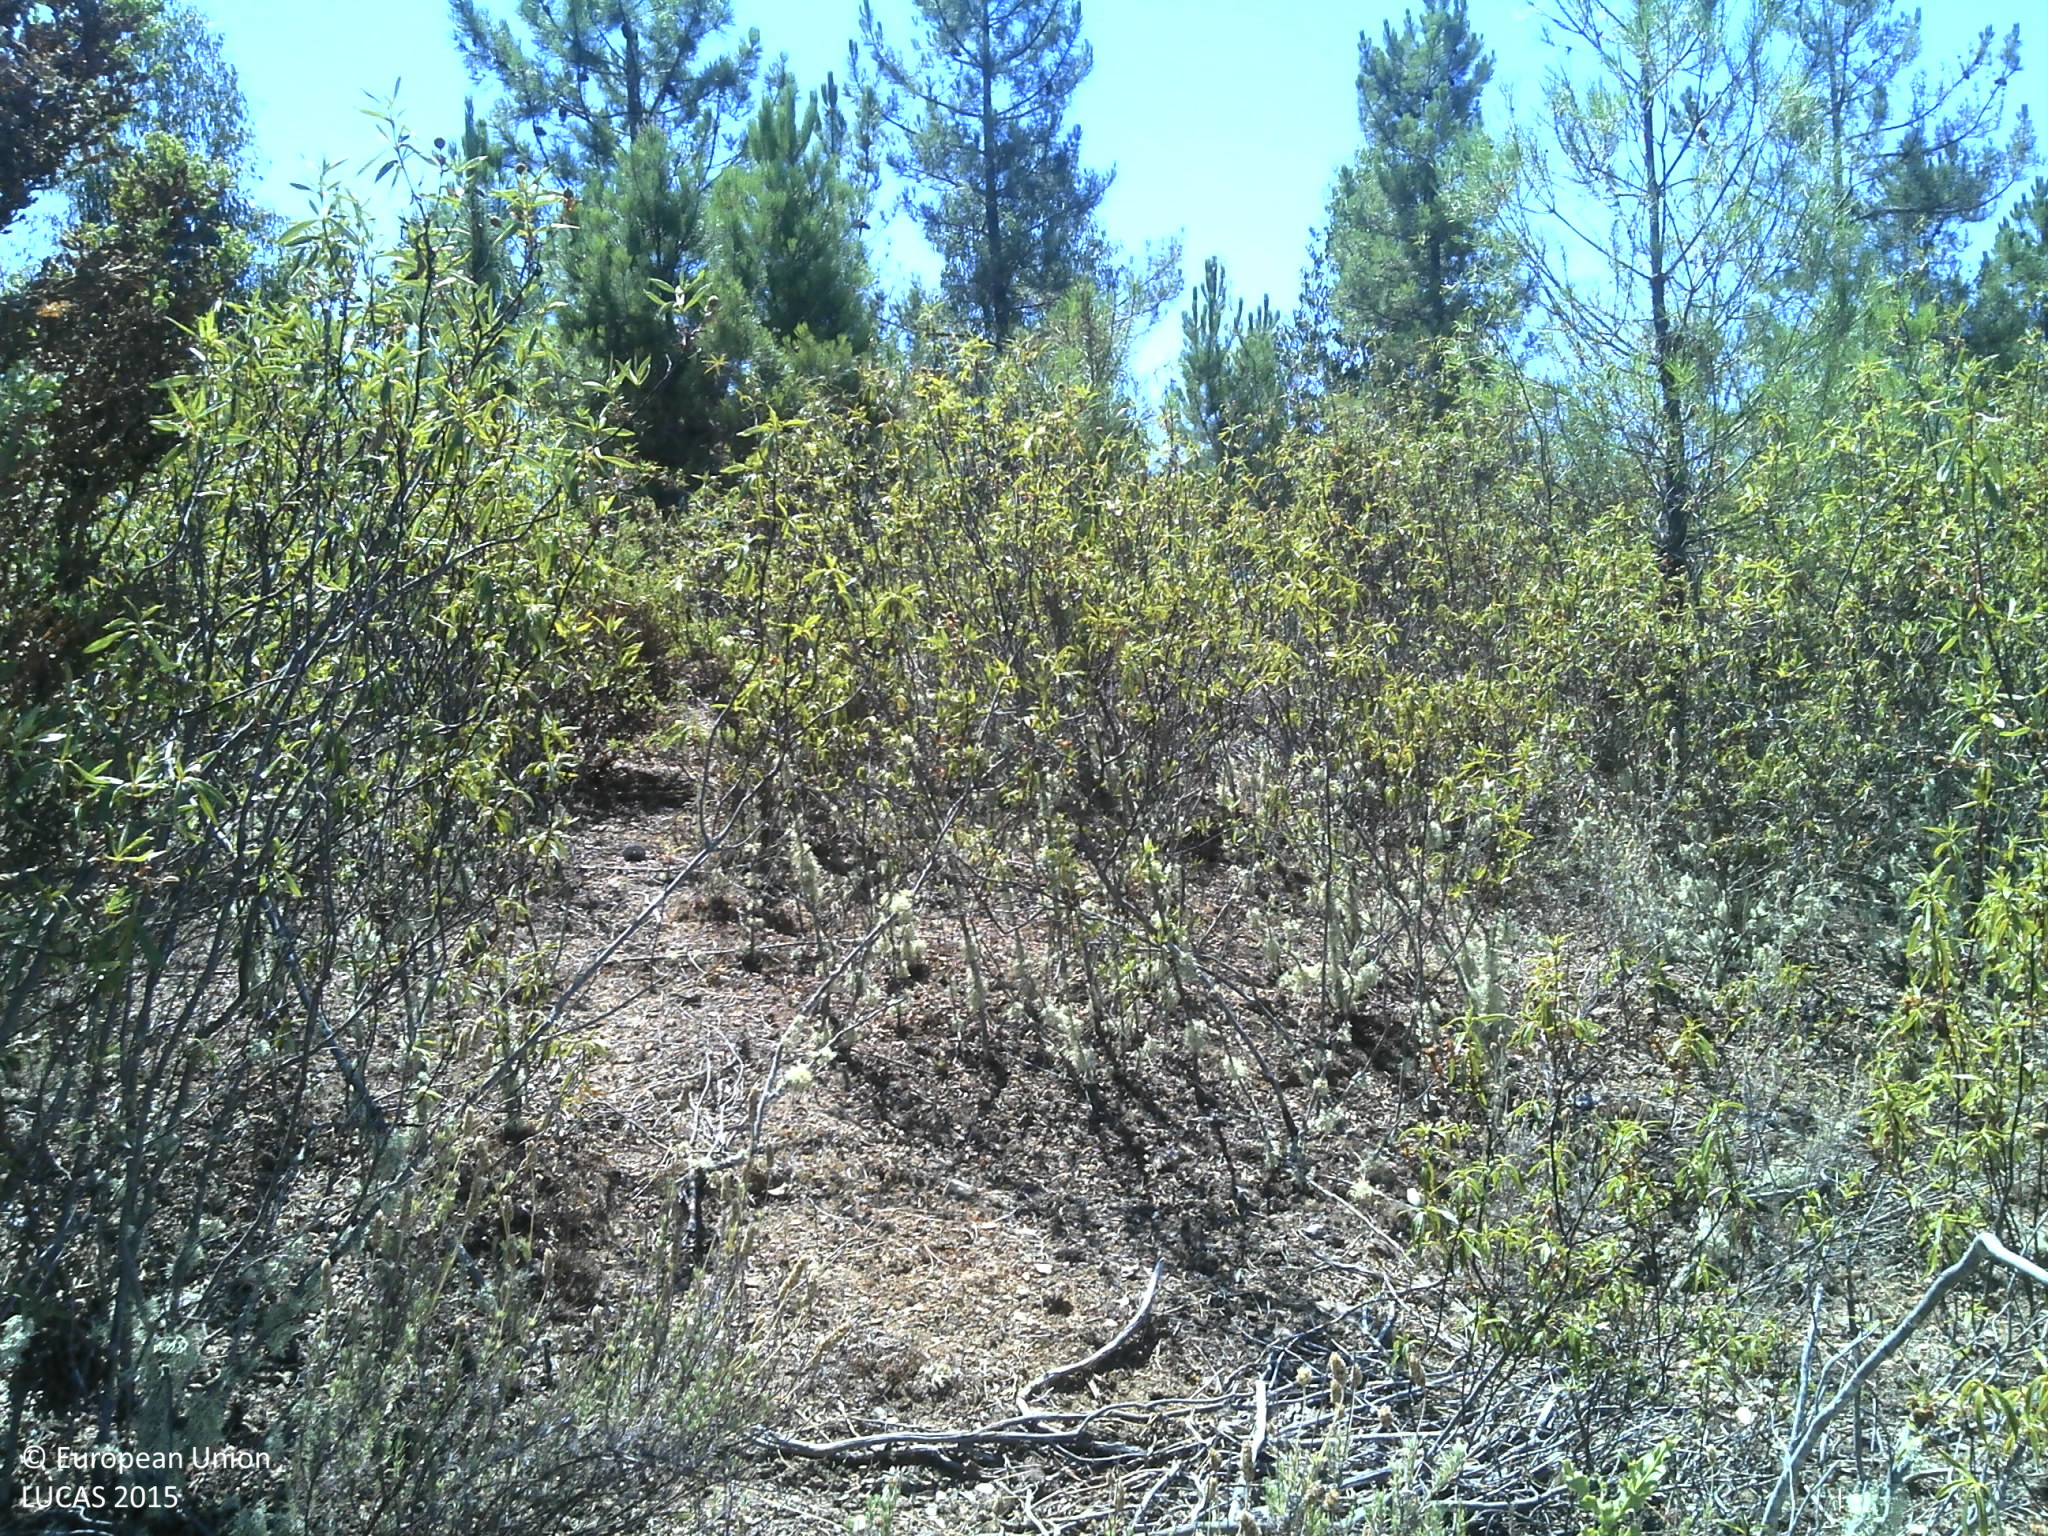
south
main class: Shrubland
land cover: Shrubland with sparse tree cover
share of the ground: > 75 %
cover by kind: shrubs 80 %, unconsolidated bare surface 15 %, coniferous forest trees 5 %
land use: Forestry
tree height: > 5 m
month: July
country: PT
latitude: 41.3647
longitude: -7.3478
